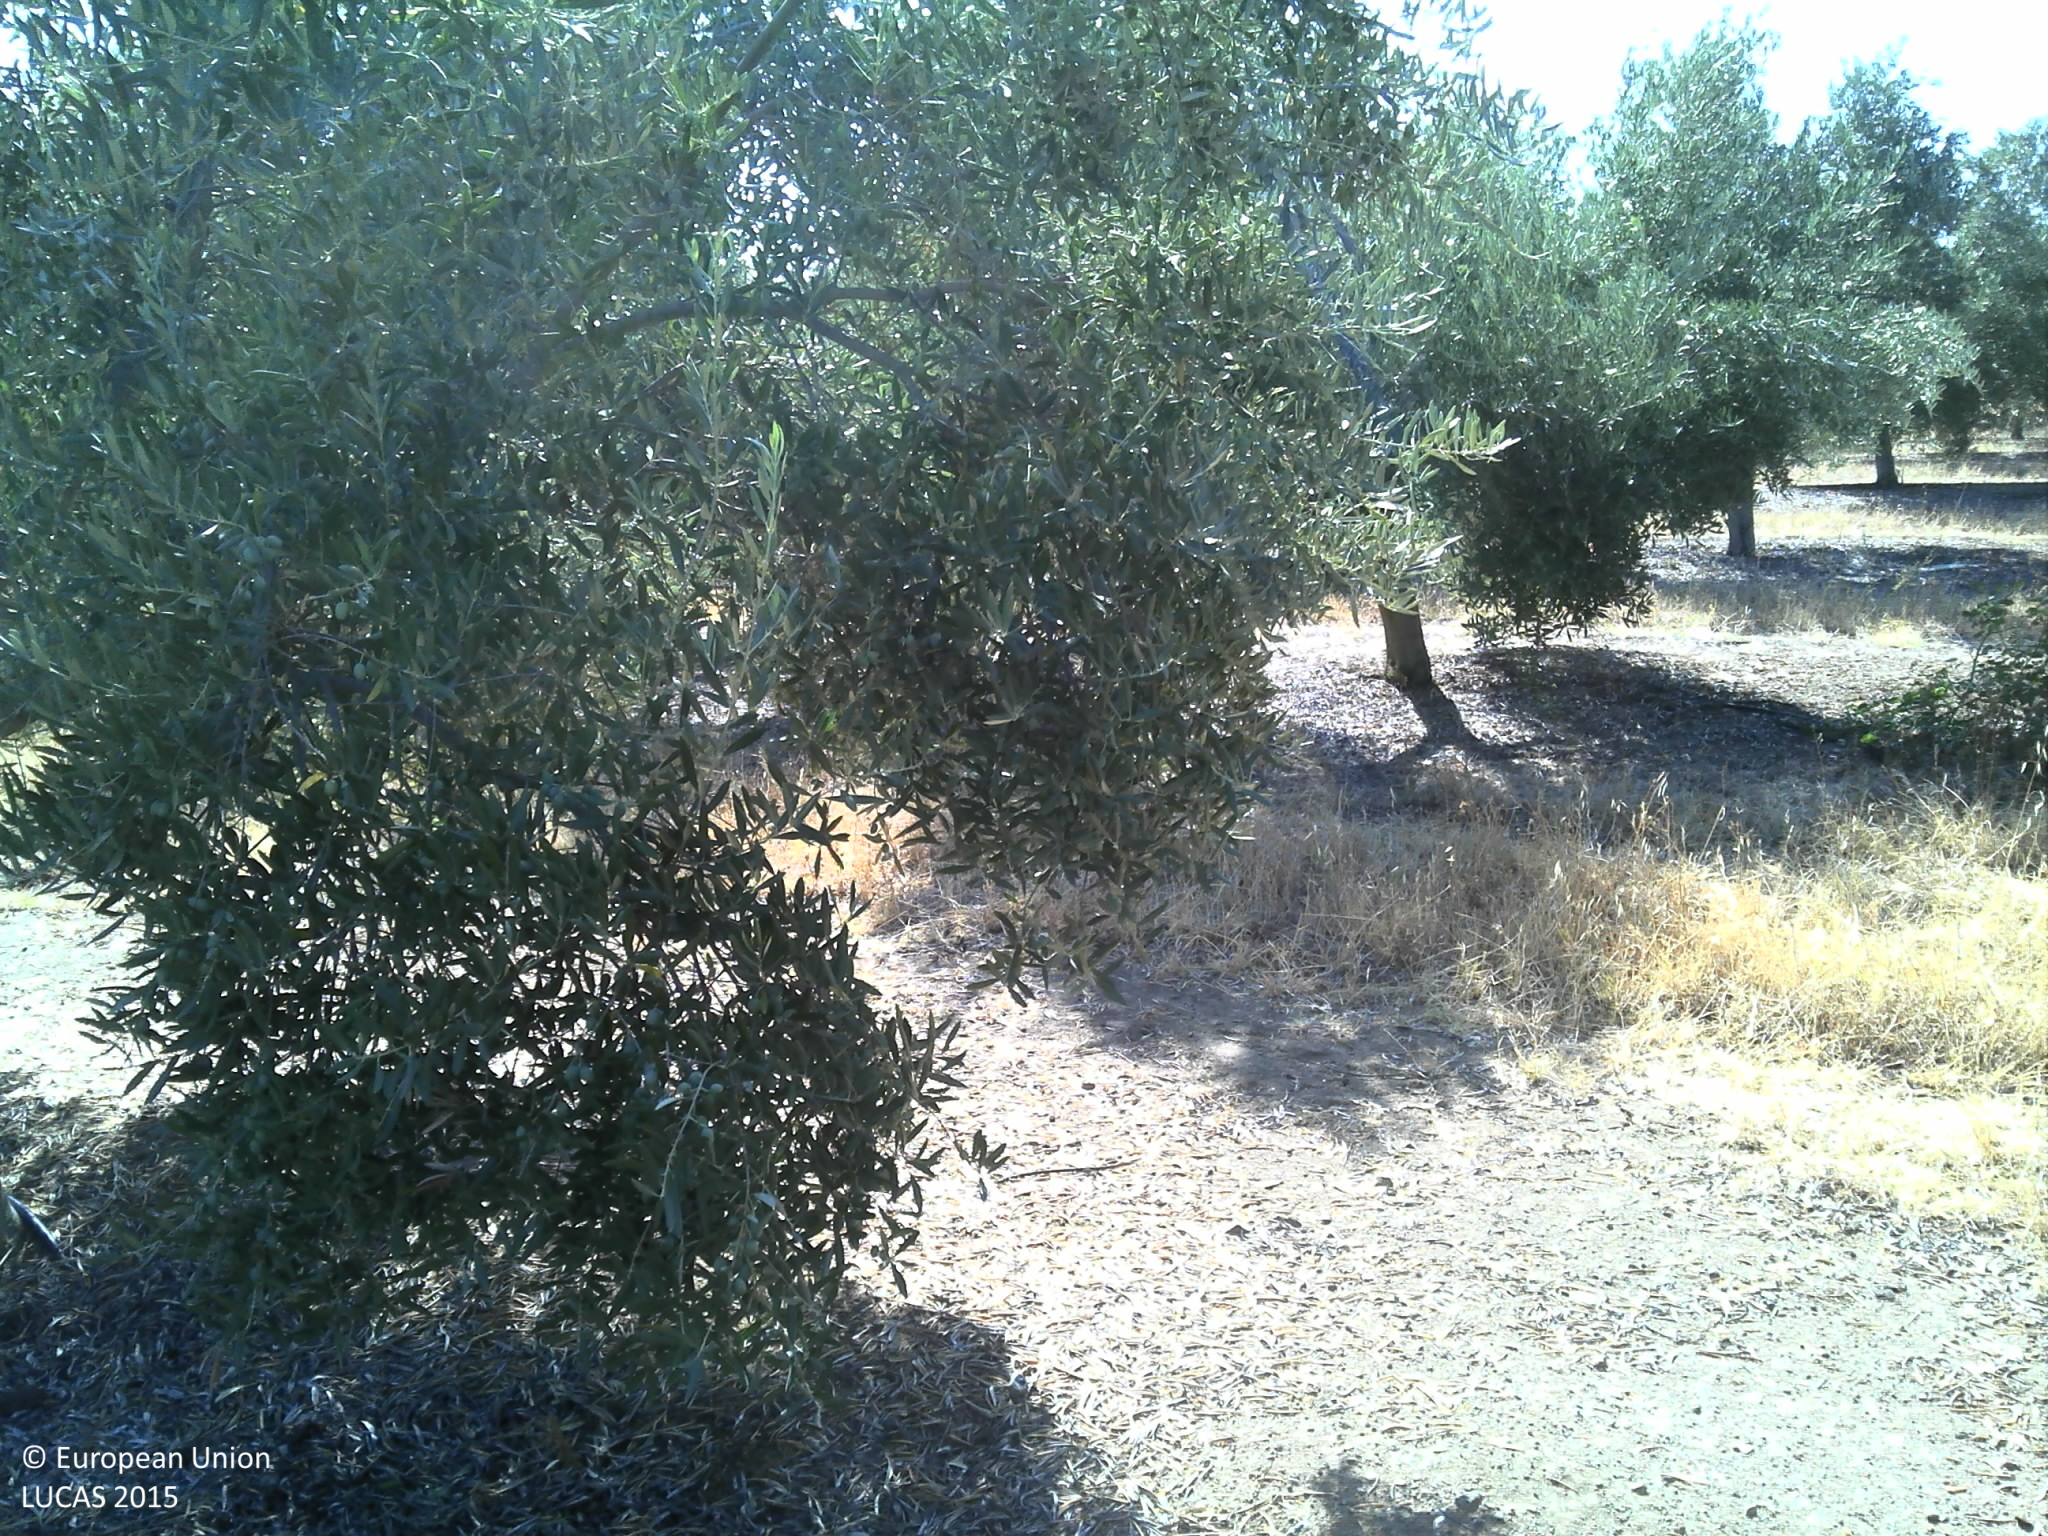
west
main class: Cropland
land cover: Olive groves
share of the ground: 50 - 75 %
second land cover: Grassland without tree/shrub cover
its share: 25 - 50 %
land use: Agriculture (excluding fallow land and kitchen gardens)
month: July
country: PT
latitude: 37.9776
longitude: -7.7034
